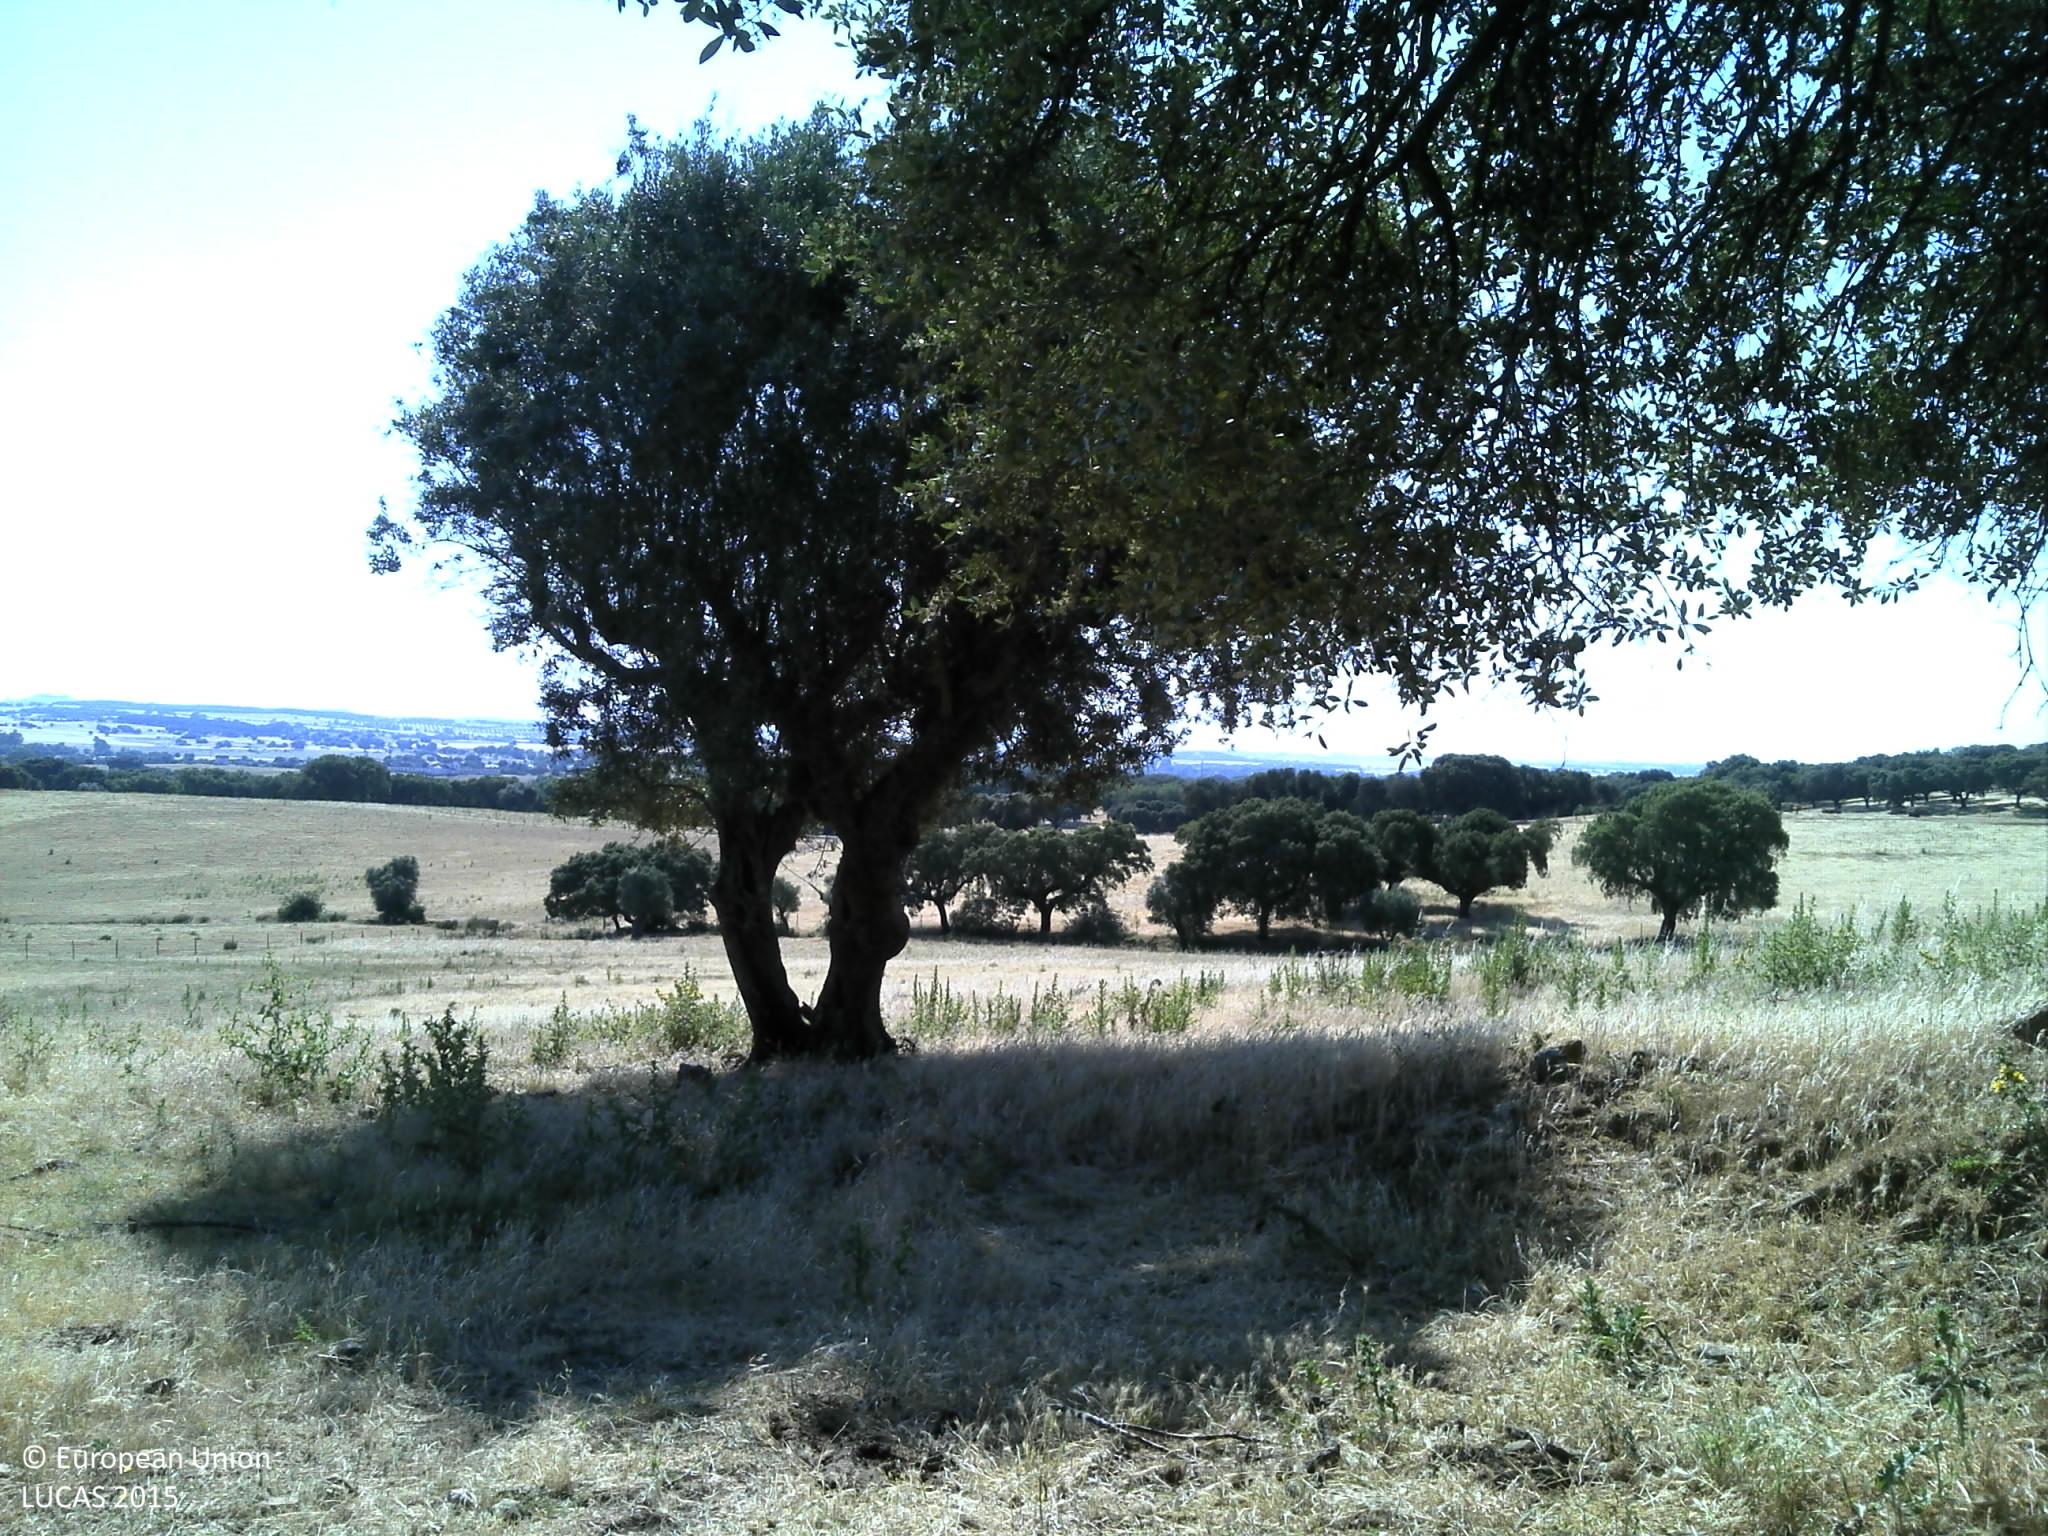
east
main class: Cropland
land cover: Olive groves
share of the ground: 10 - 25 %
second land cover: Grassland without tree/shrub cover
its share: > 75 %
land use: Agriculture (excluding fallow land and kitchen gardens)
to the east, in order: Olive groves; Grassland without tree/shrub cover; Olive groves; Grassland without tree/shrub cover; Broadleaved woodland; Rivers and streams; Fences; Grassland without tree/shrub cover
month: June
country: PT
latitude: 38.6998
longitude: -8.0871
